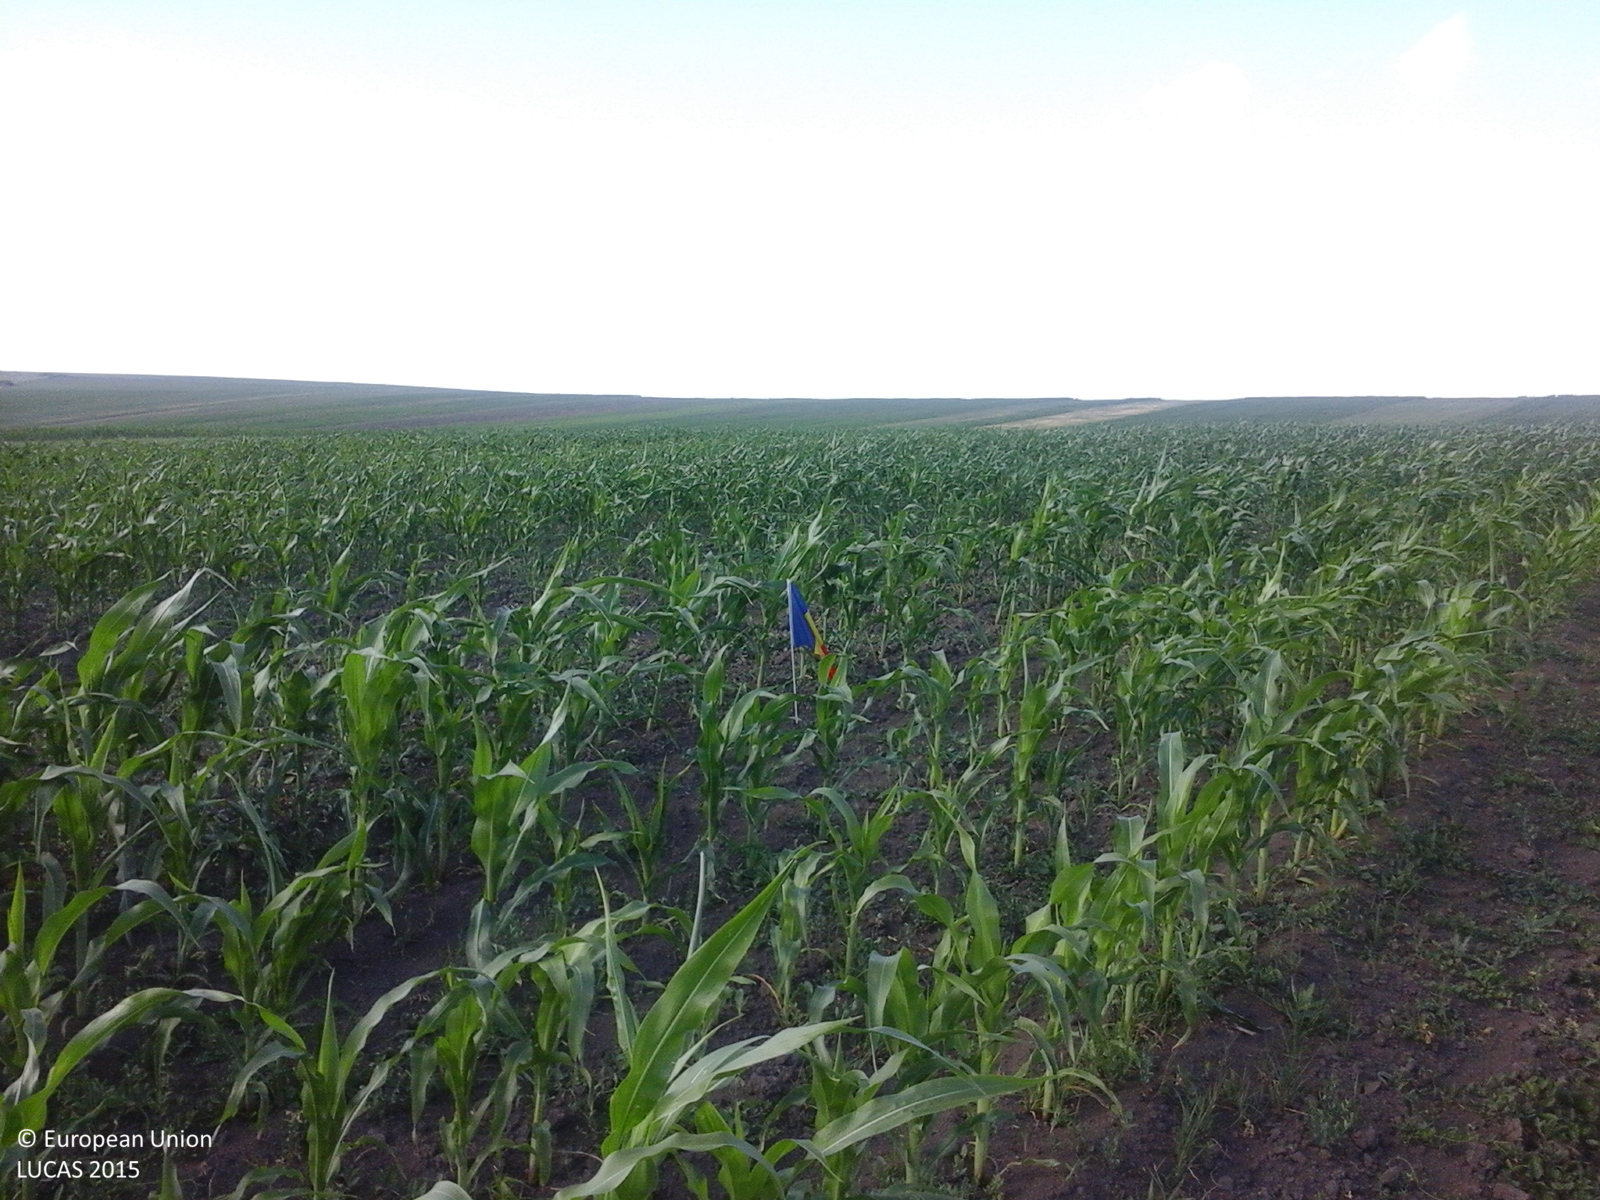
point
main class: Cropland
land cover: Maize
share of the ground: 25 - 50 %
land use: Agriculture (excluding fallow land and kitchen gardens)
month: June
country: RO
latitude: 47.7081
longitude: 26.8259
